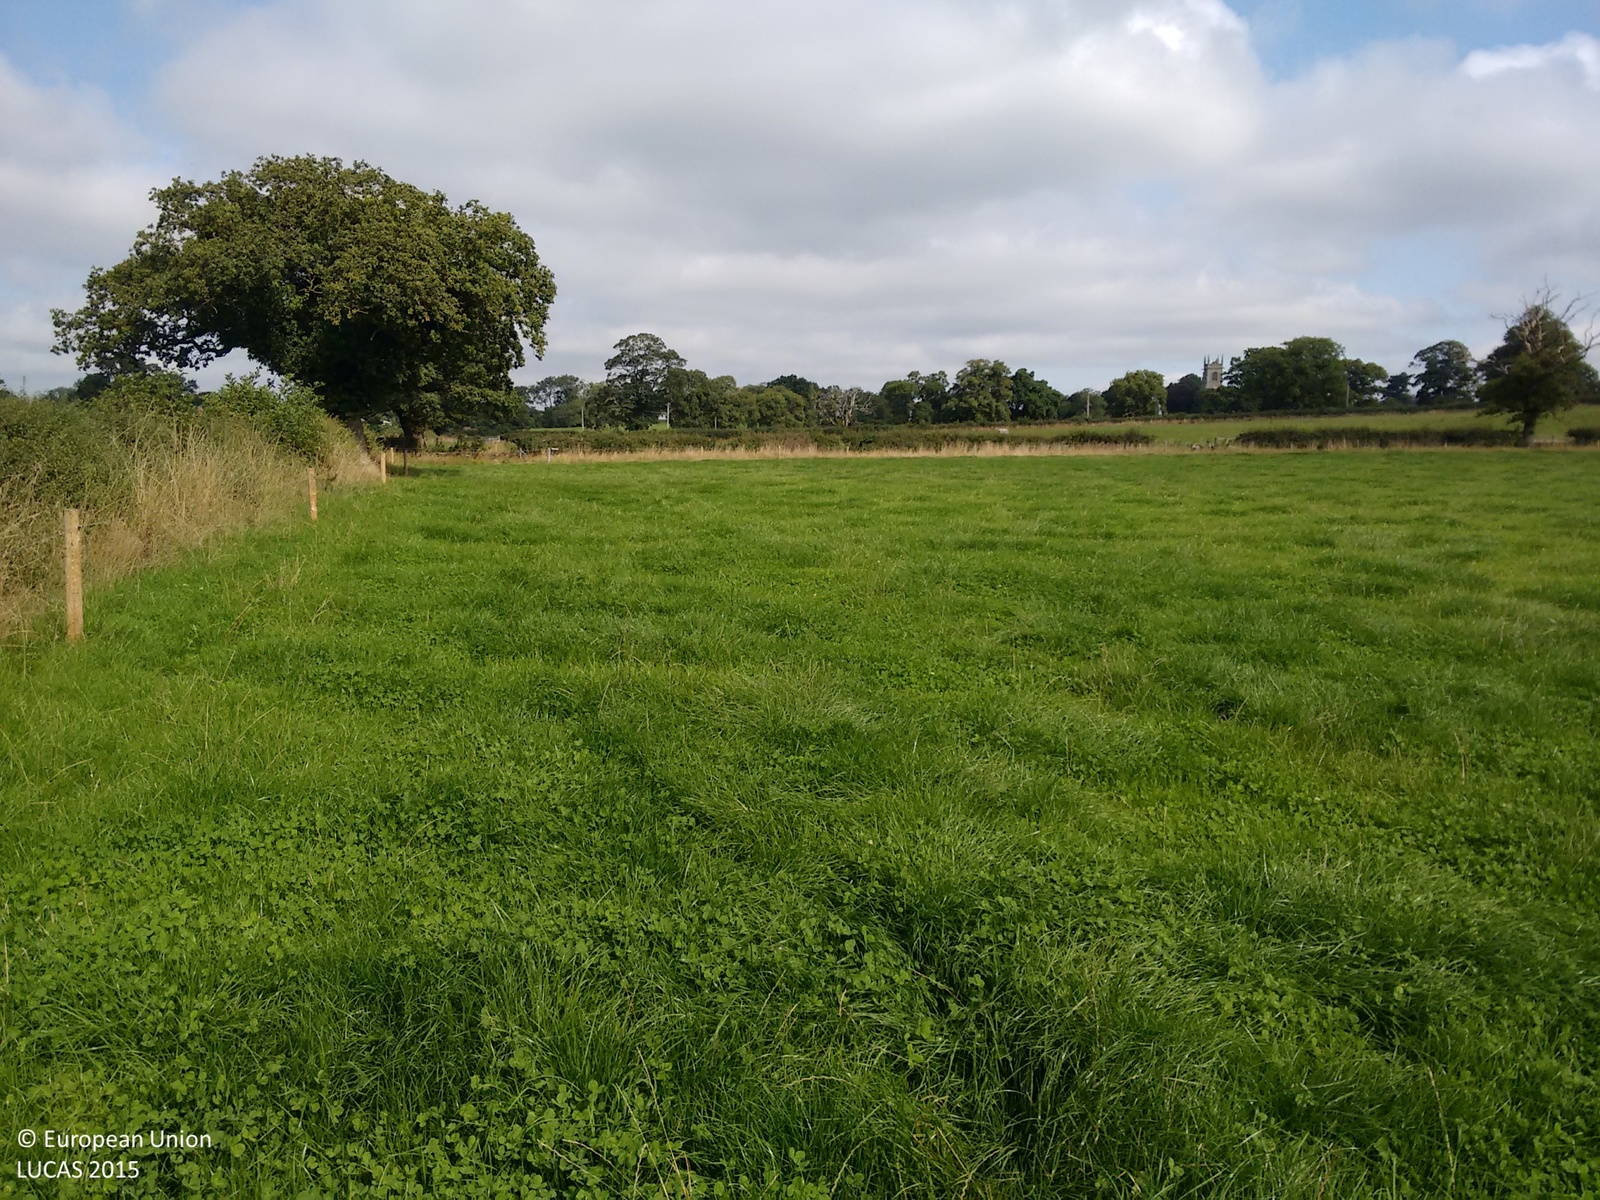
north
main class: Grassland
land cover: Grassland without tree/shrub cover
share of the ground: > 75 %
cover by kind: herbaceous plants 100 %
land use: Agriculture (excluding fallow land and kitchen gardens)
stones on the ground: < 10 %
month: September
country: GB
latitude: 52.9395
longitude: -2.6116
